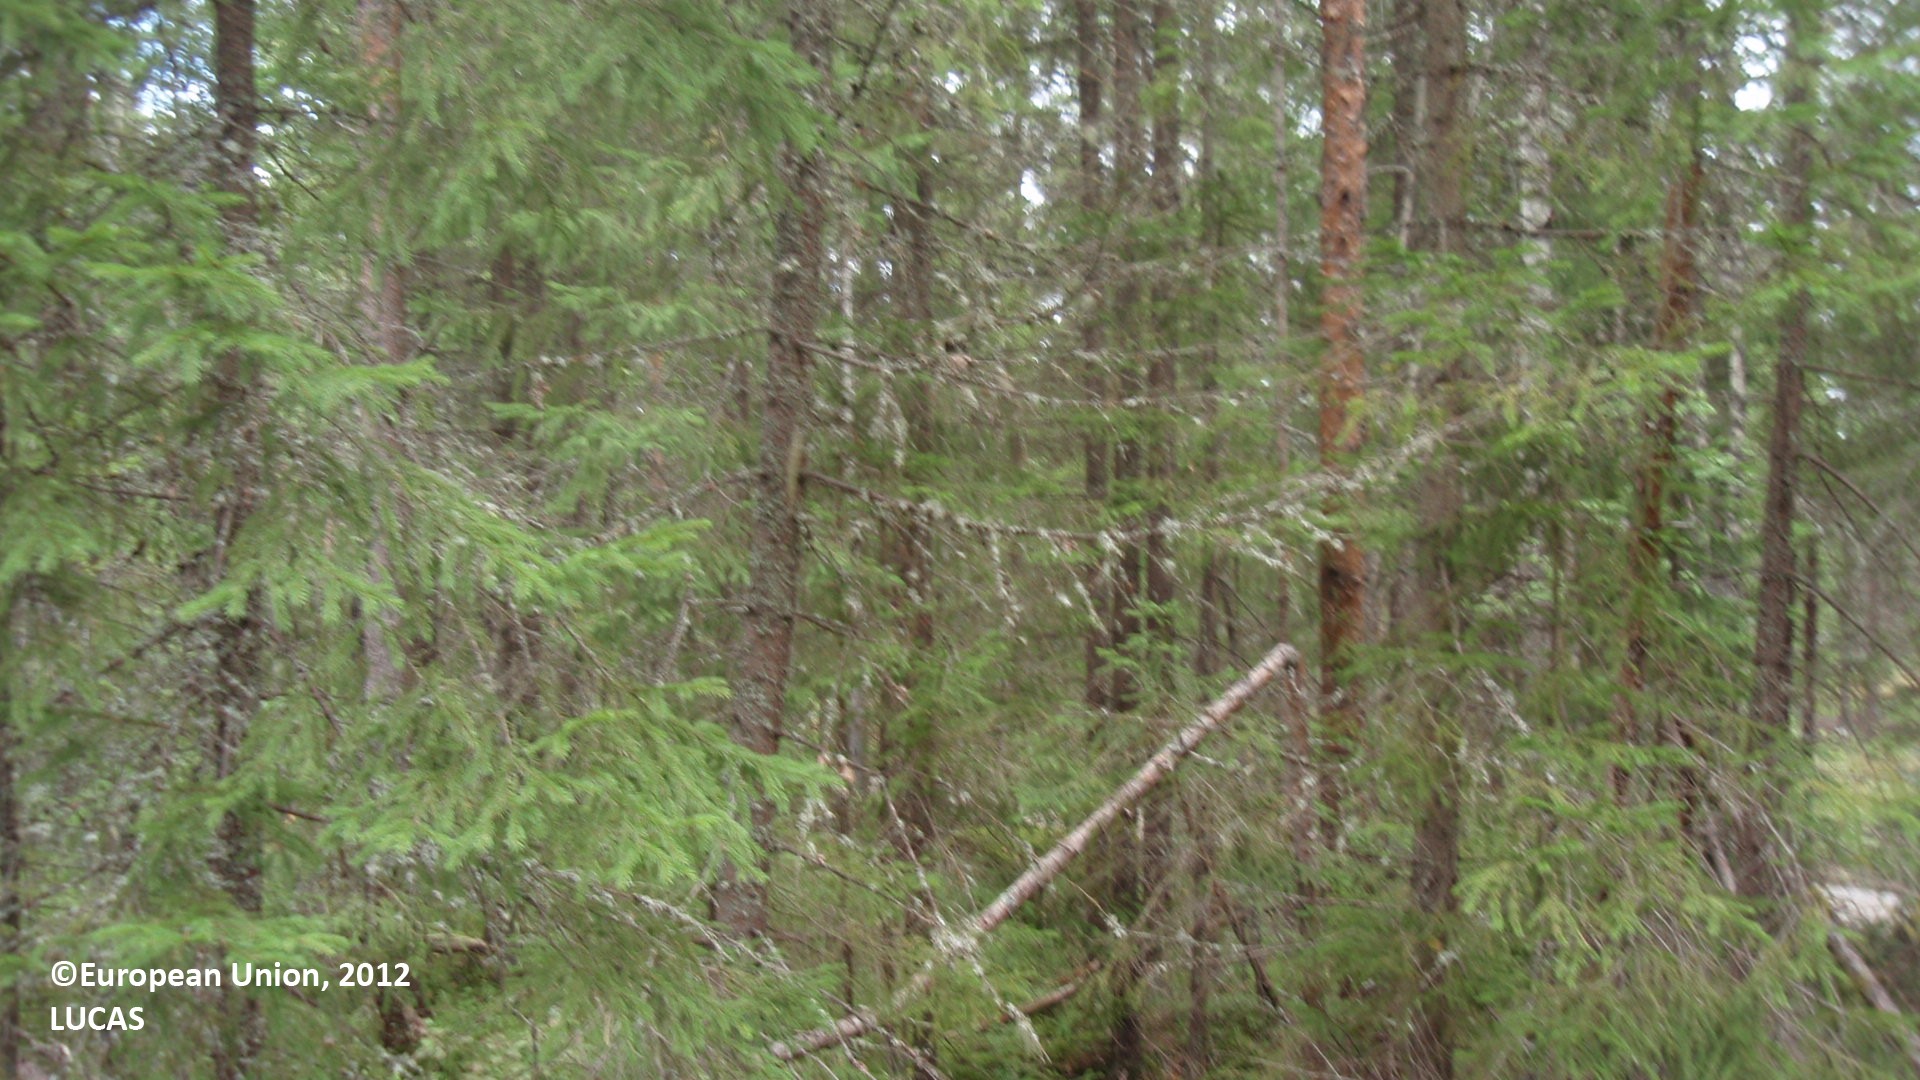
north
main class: Woodland
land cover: Pine dominated mixed woodland
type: boreal forest
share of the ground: 50 - 75 %
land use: Forestry
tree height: > 5 m
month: August
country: FI
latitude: 60.7507
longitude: 27.4097
